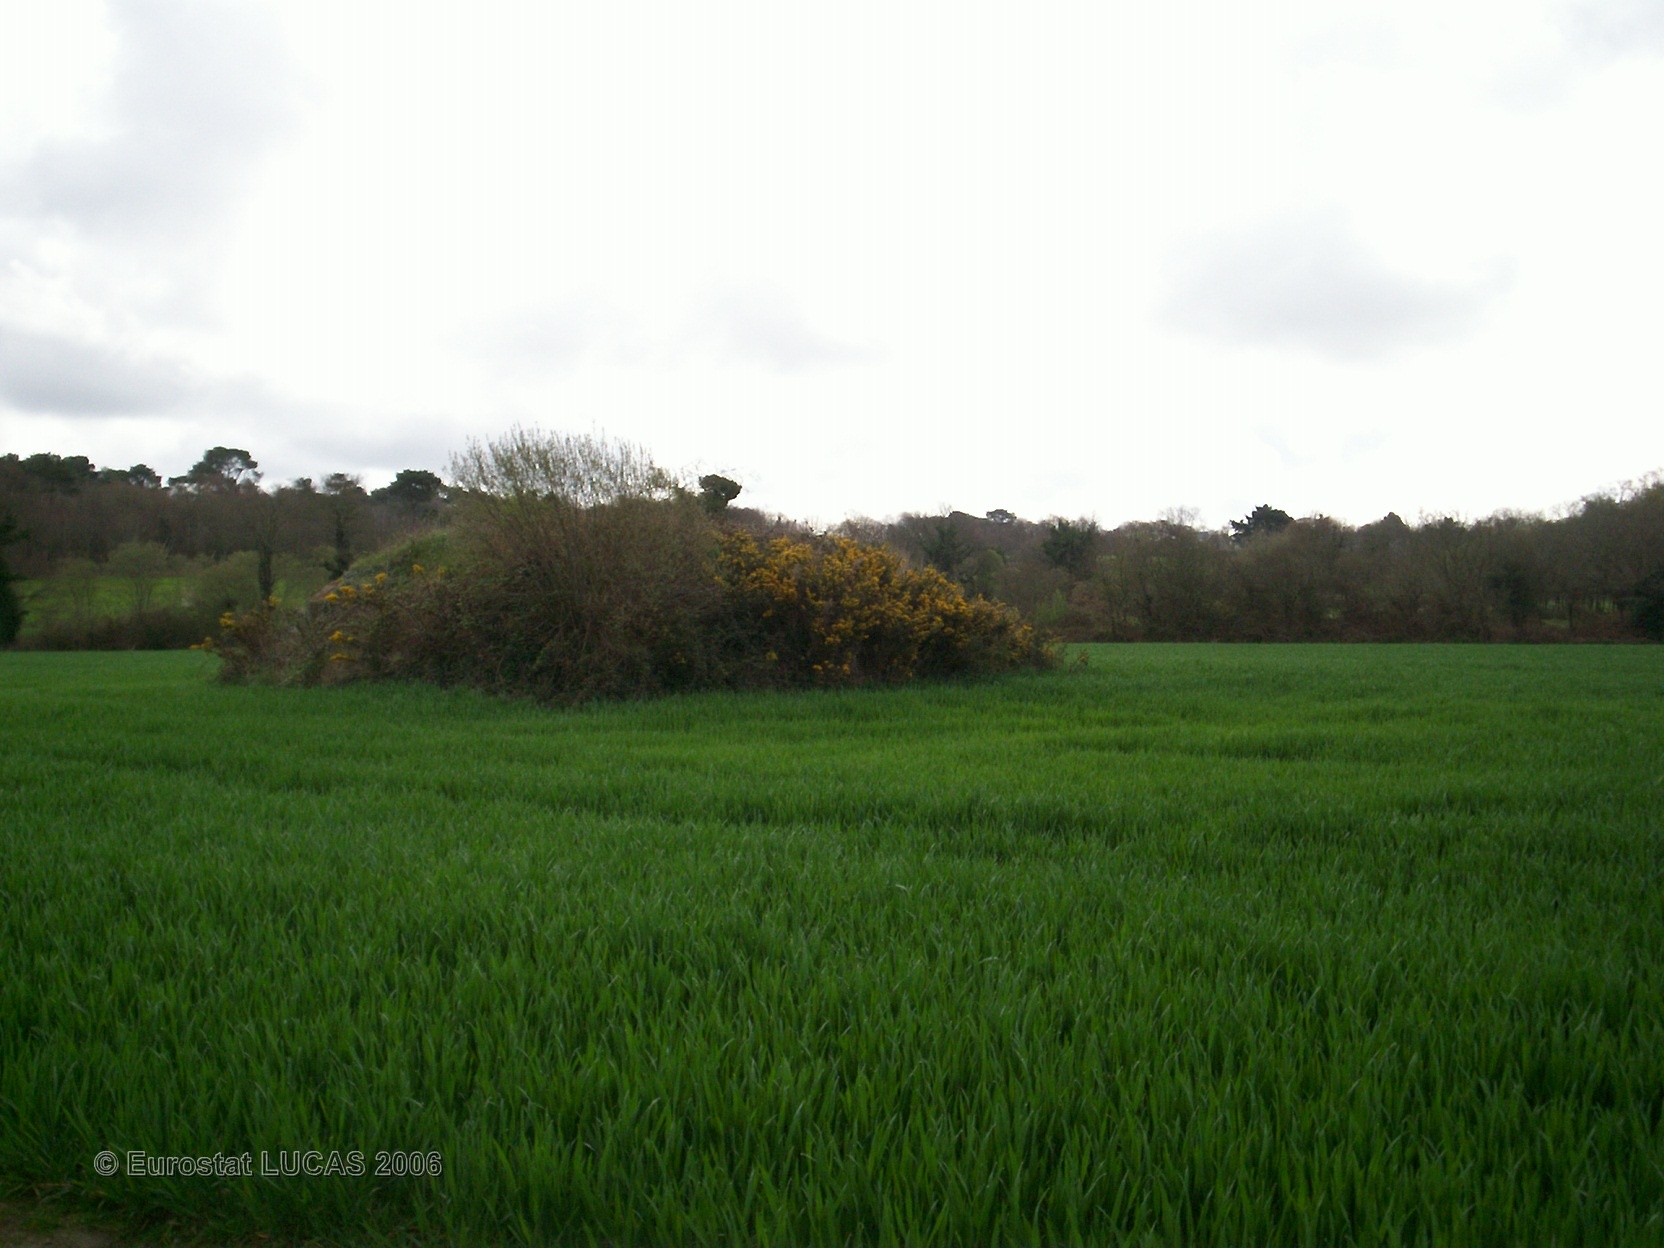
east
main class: Cropland
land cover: Triticale
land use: Agriculture (excluding fallow land and kitchen gardens)
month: April
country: FR
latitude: 47.7412
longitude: -3.4505
